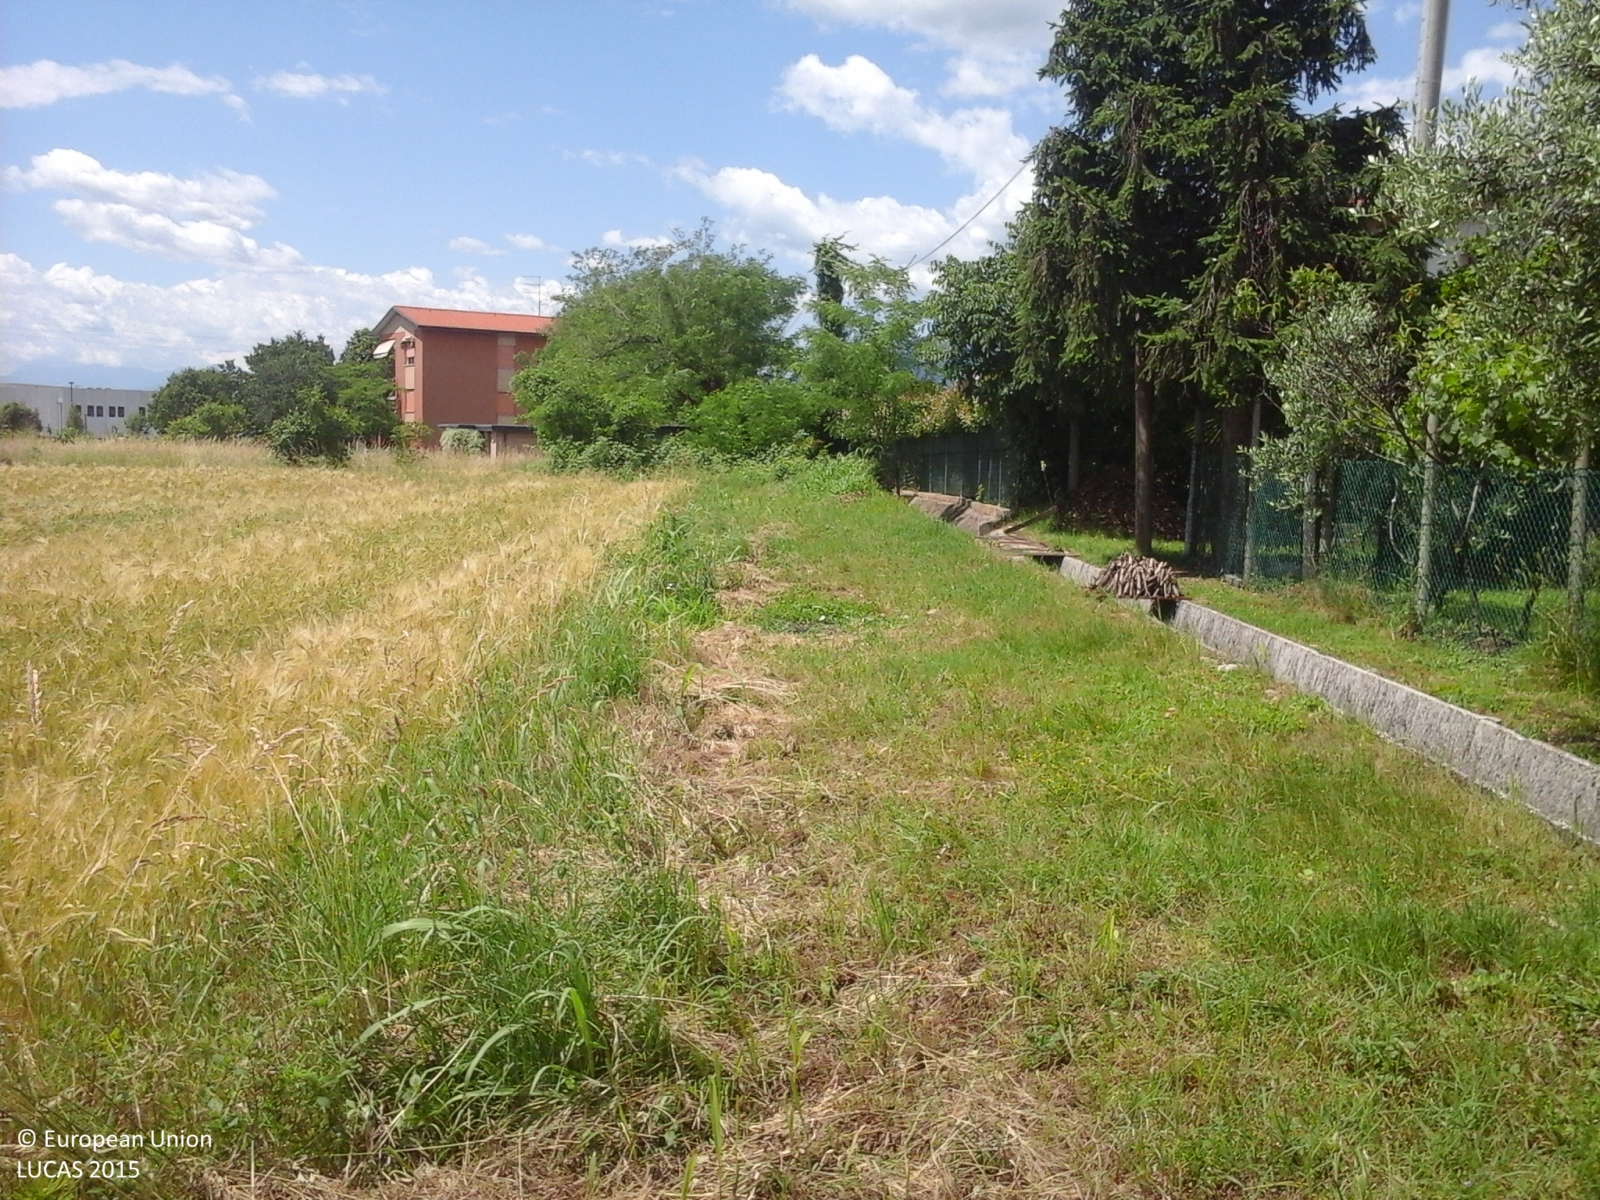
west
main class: Cropland
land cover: Barley
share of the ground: > 75 %
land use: Agriculture (excluding fallow land and kitchen gardens)
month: May
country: IT
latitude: 45.7425
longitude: 11.7325
